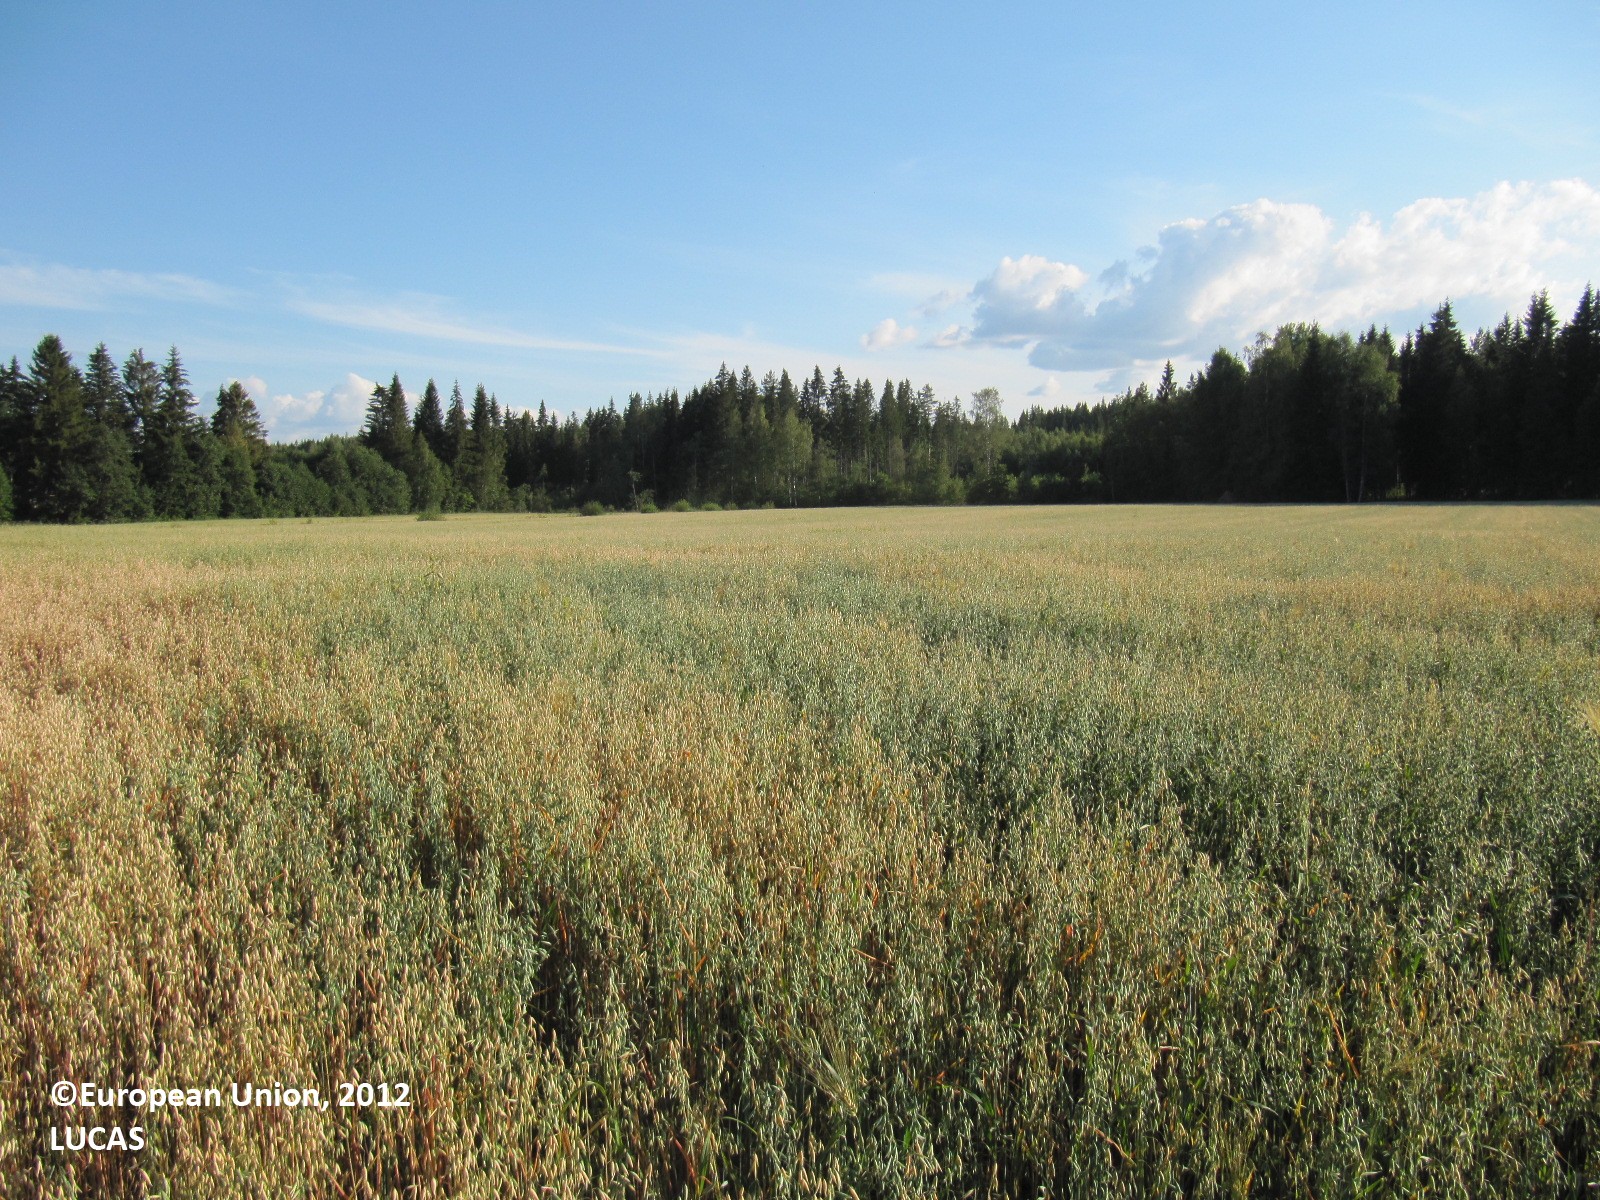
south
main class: Cropland
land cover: Oats
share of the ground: > 75 %
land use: Agriculture (excluding fallow land and kitchen gardens)
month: August
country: FI
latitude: 60.5499
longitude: 24.4548
